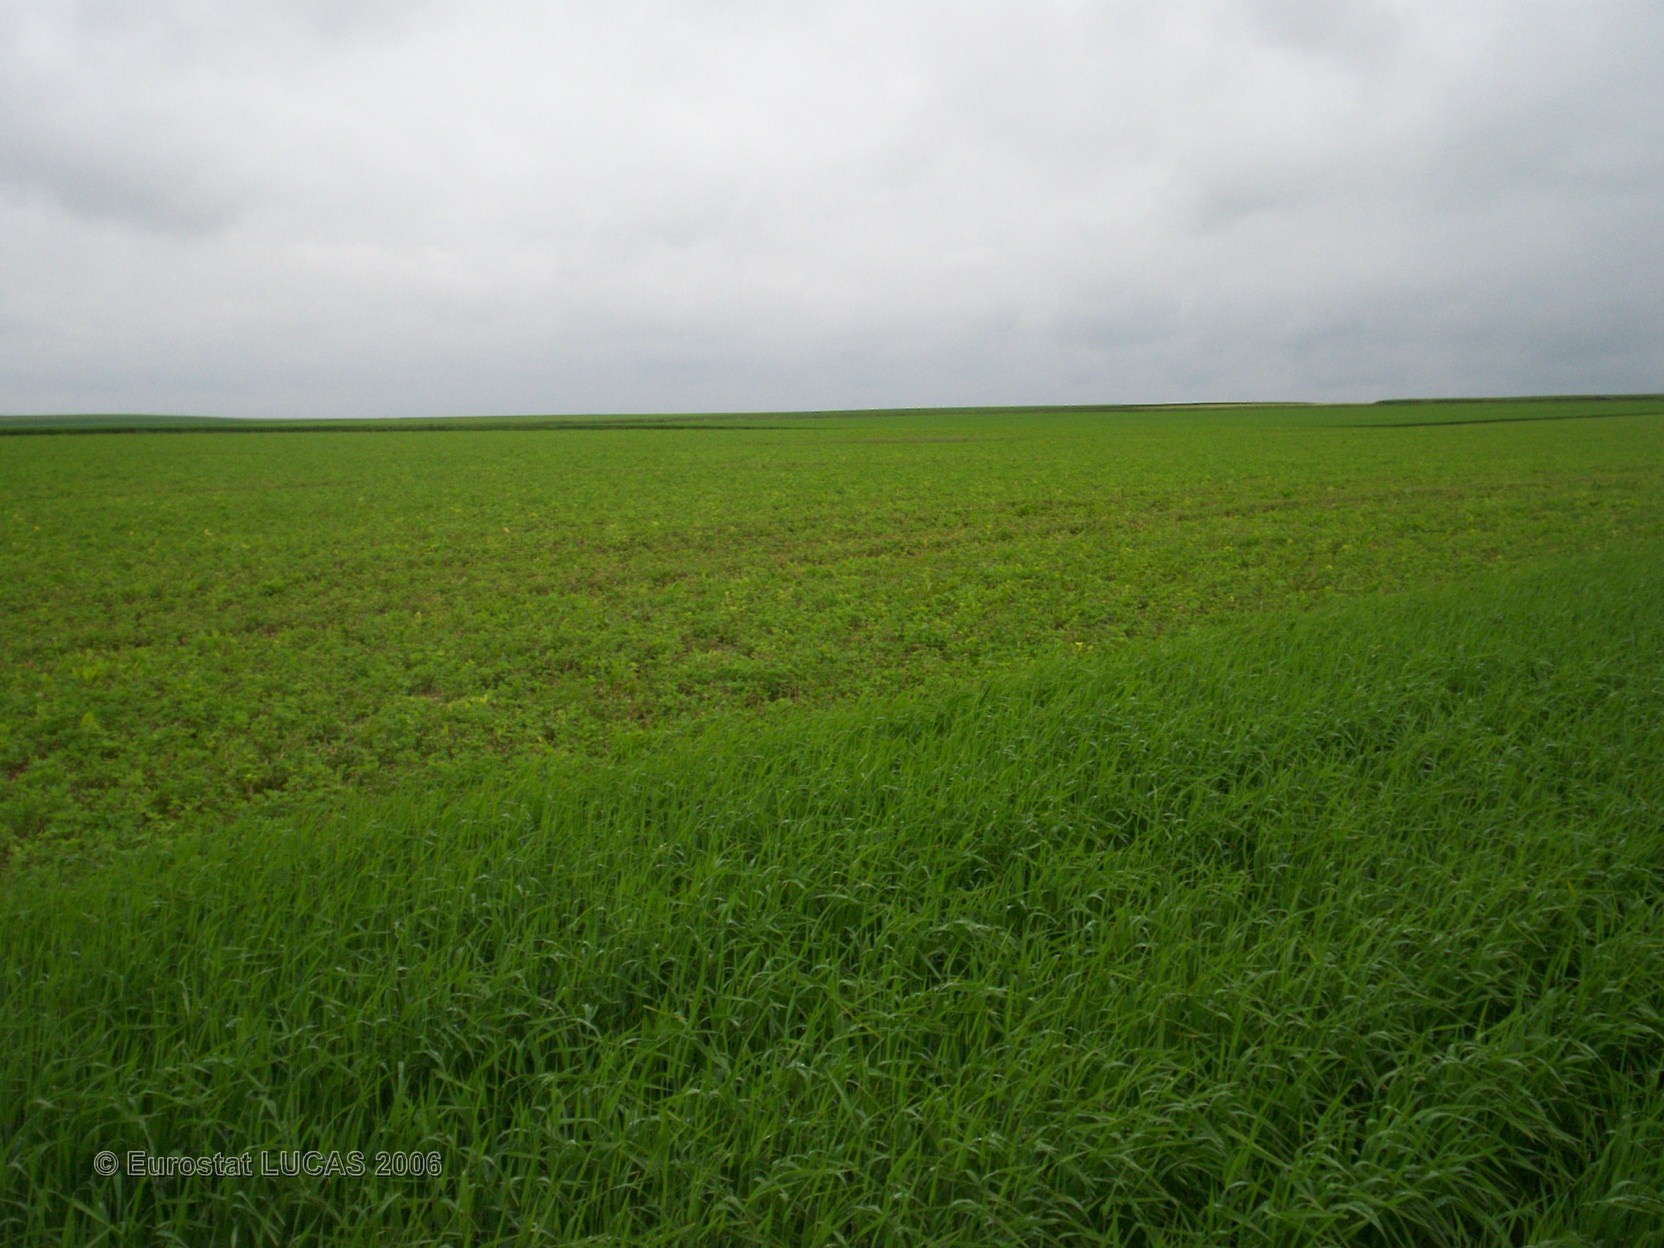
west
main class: Cropland
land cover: Barley
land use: Agriculture (excluding fallow land and kitchen gardens)
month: May
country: FR
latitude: 49.3281
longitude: 4.4511
